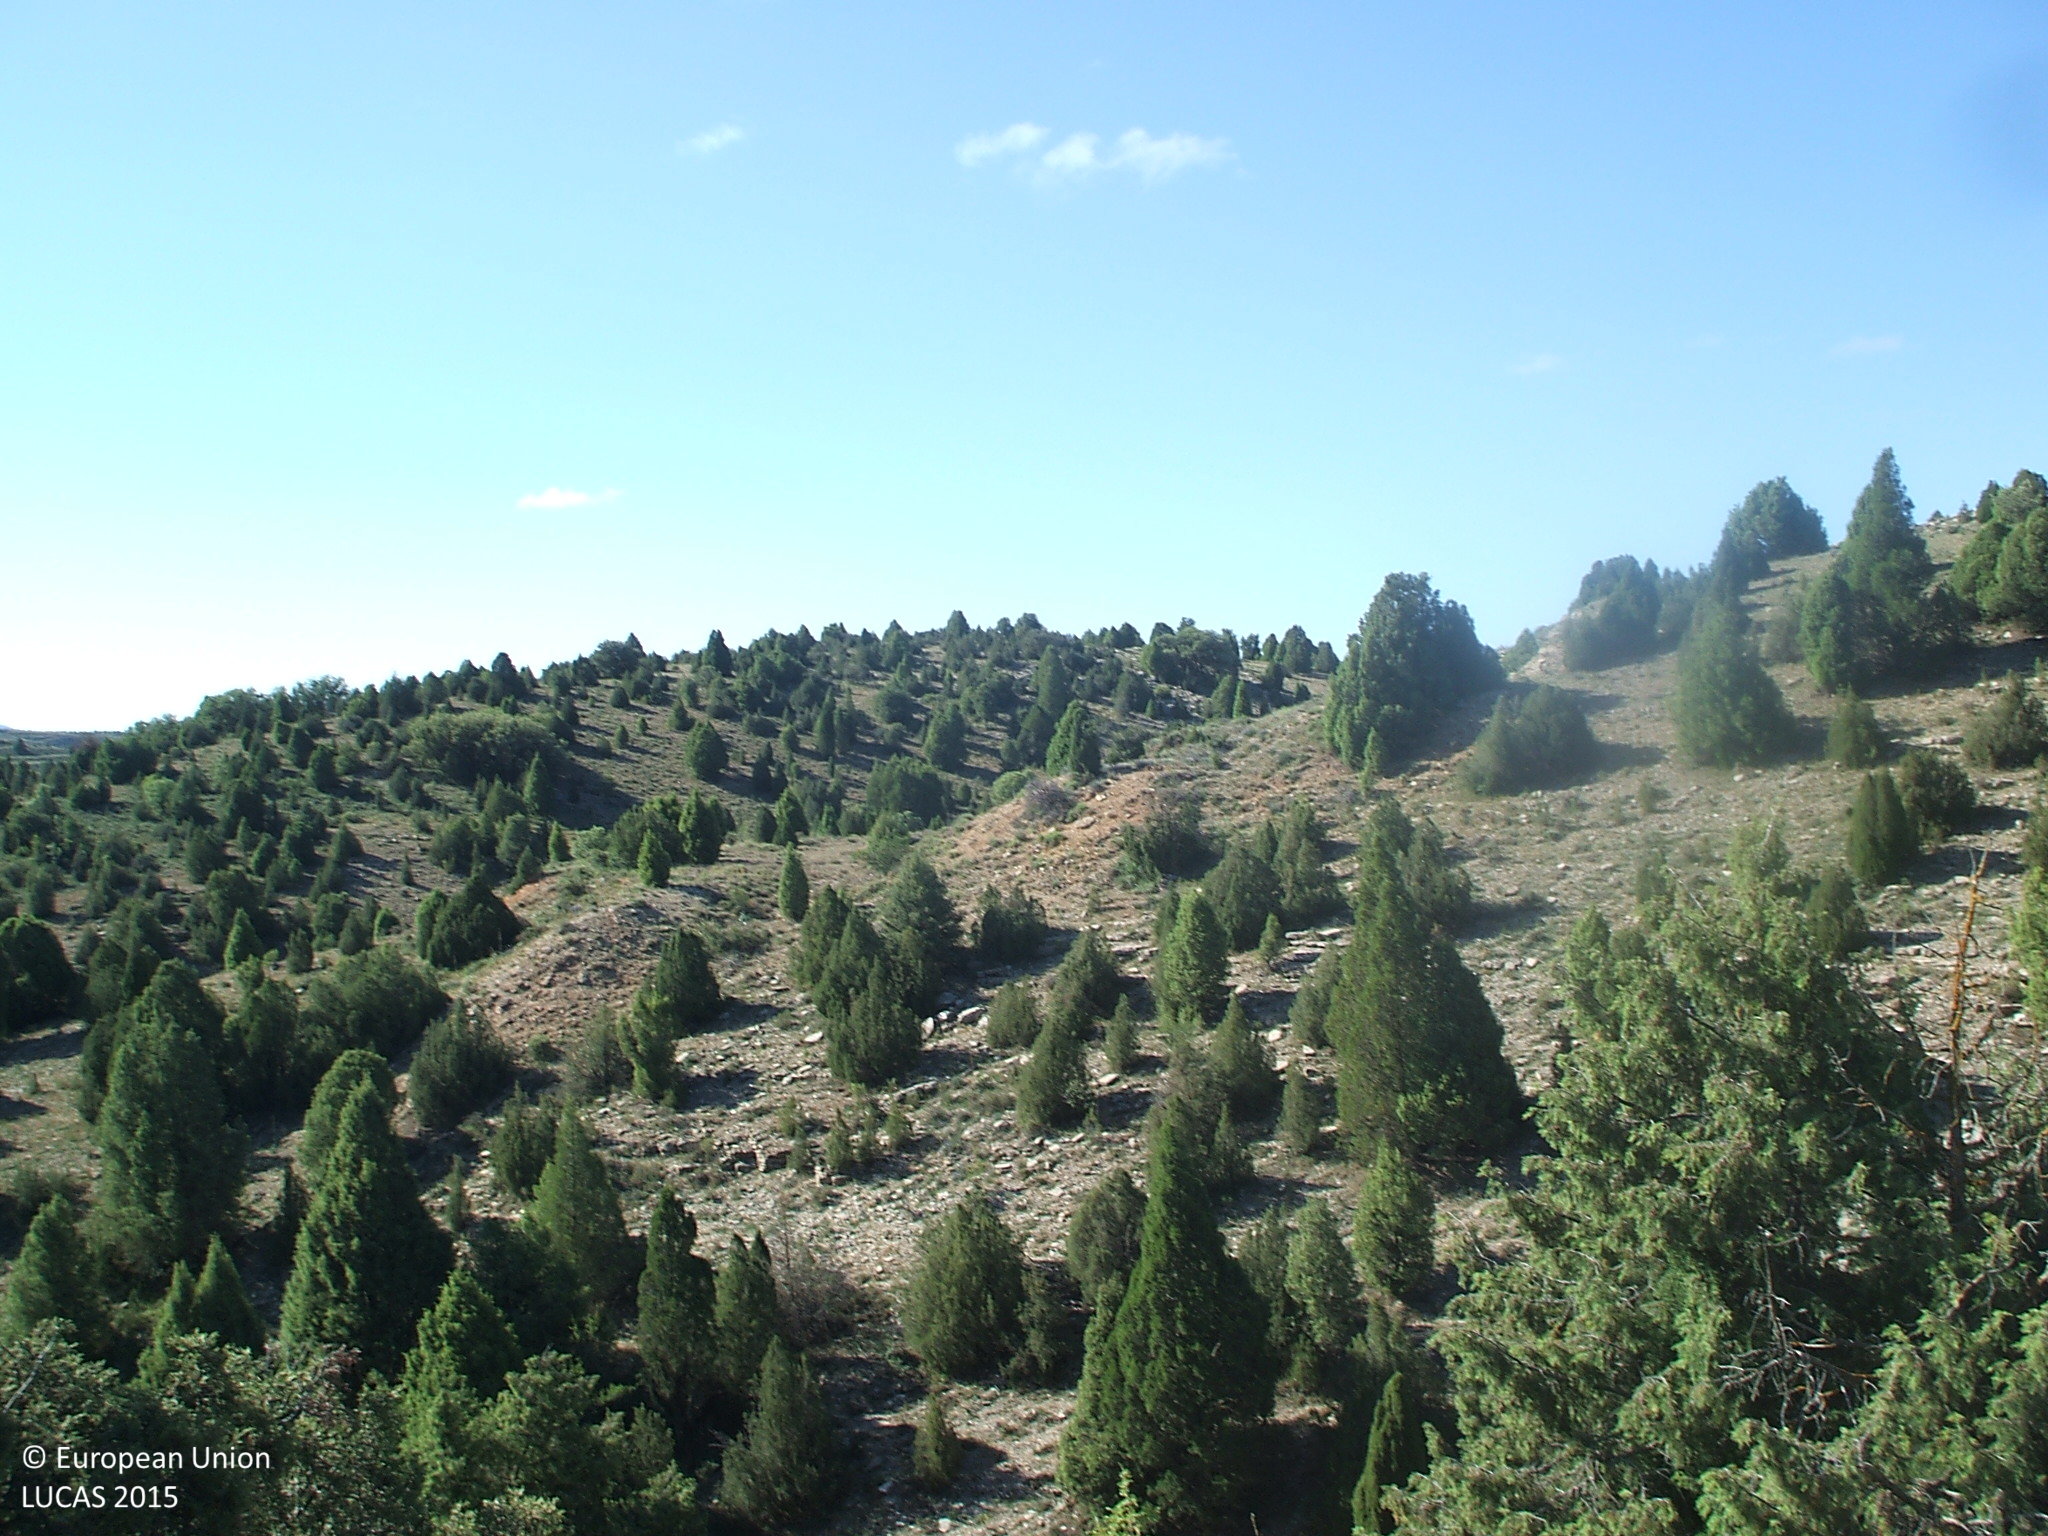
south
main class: Shrubland
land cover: Shrubland with sparse tree cover
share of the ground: 25 - 50 %
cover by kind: consolidated bare surface 75 %, shrubs 20 %, coniferous forest trees 5 %
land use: Semi-natural and natural areas not in use
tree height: < 5 m
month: May
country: ES
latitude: 40.1289
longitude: -0.7675
